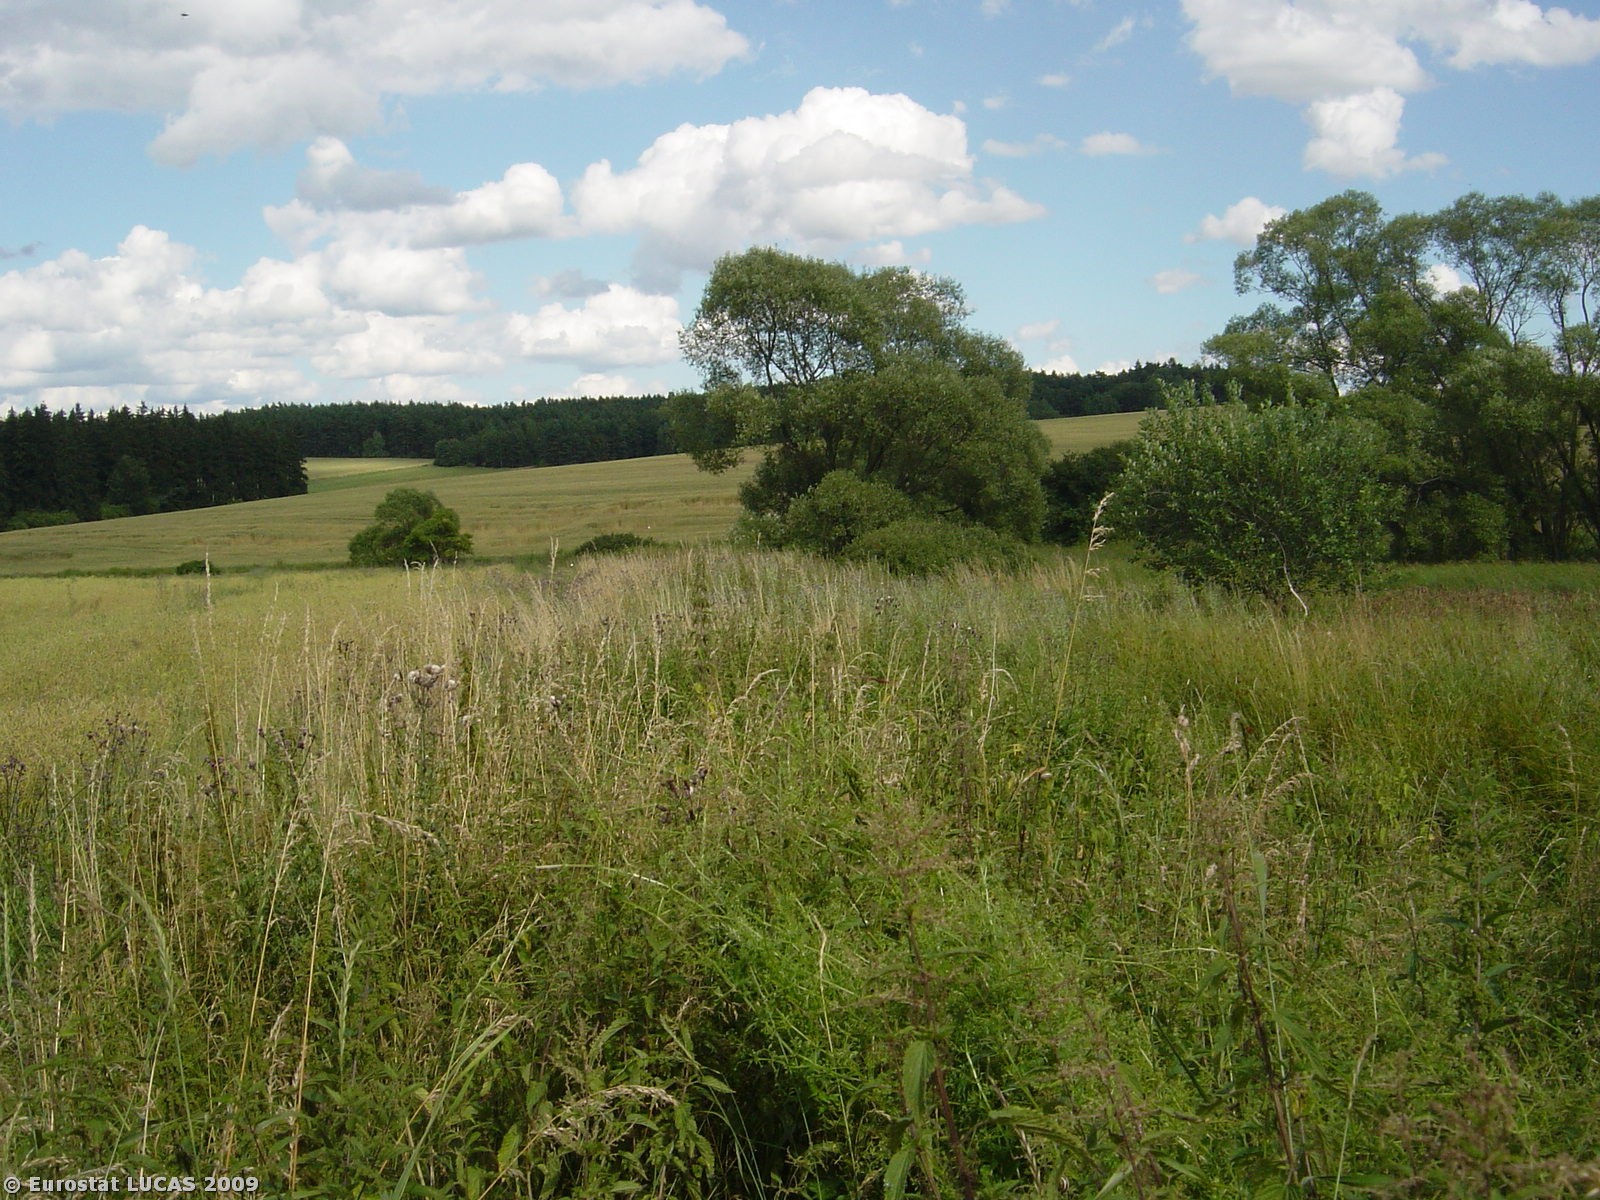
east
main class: Grassland
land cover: Spontaneously vegetated surfaces
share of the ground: > 75 %
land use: Unused
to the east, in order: Spontaneously vegetated surfaces; Rivers and streams; Spontaneously vegetated surfaces; Common wheat
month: July
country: CZ
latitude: 49.7335
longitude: 12.8995
